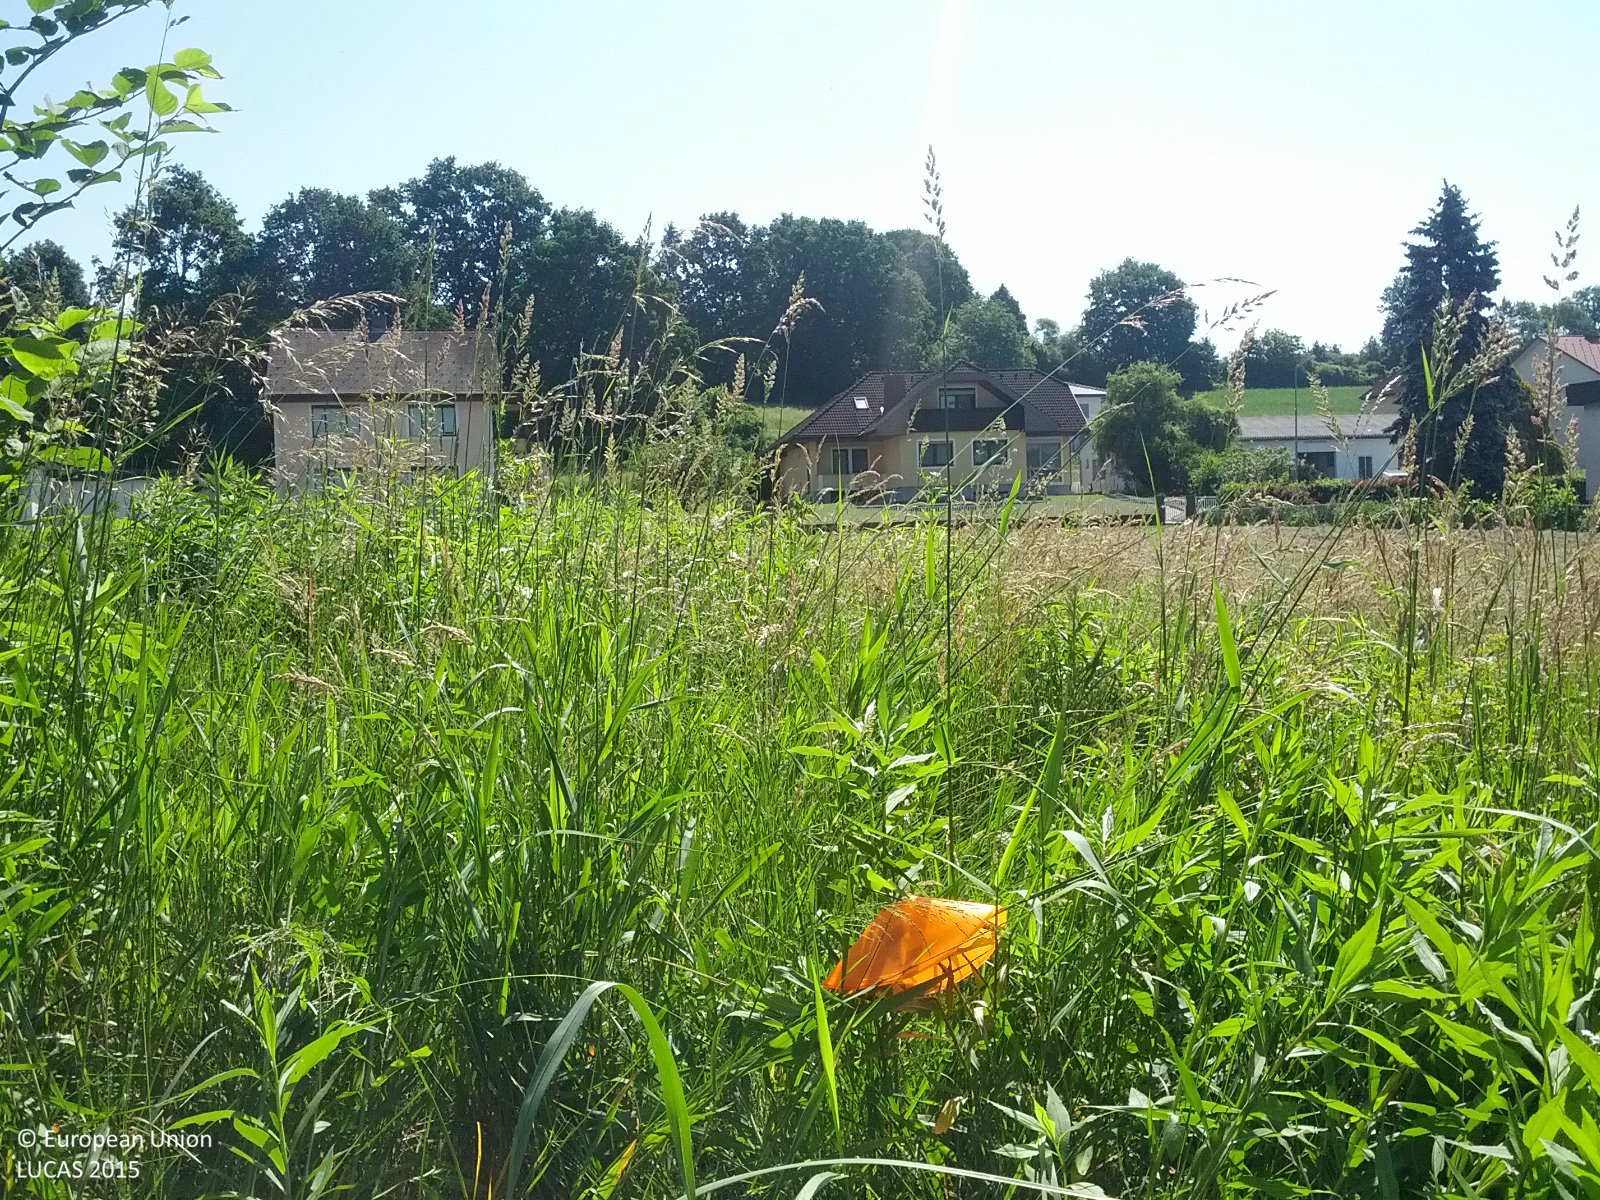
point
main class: Grassland
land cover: Grassland without tree/shrub cover
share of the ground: > 75 %
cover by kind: herbaceous plants 90 %, shrubs 5 %, unconsolidated bare surface 5 %
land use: Abandoned areas
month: June
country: AT
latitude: 47.1667
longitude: 16.1626
